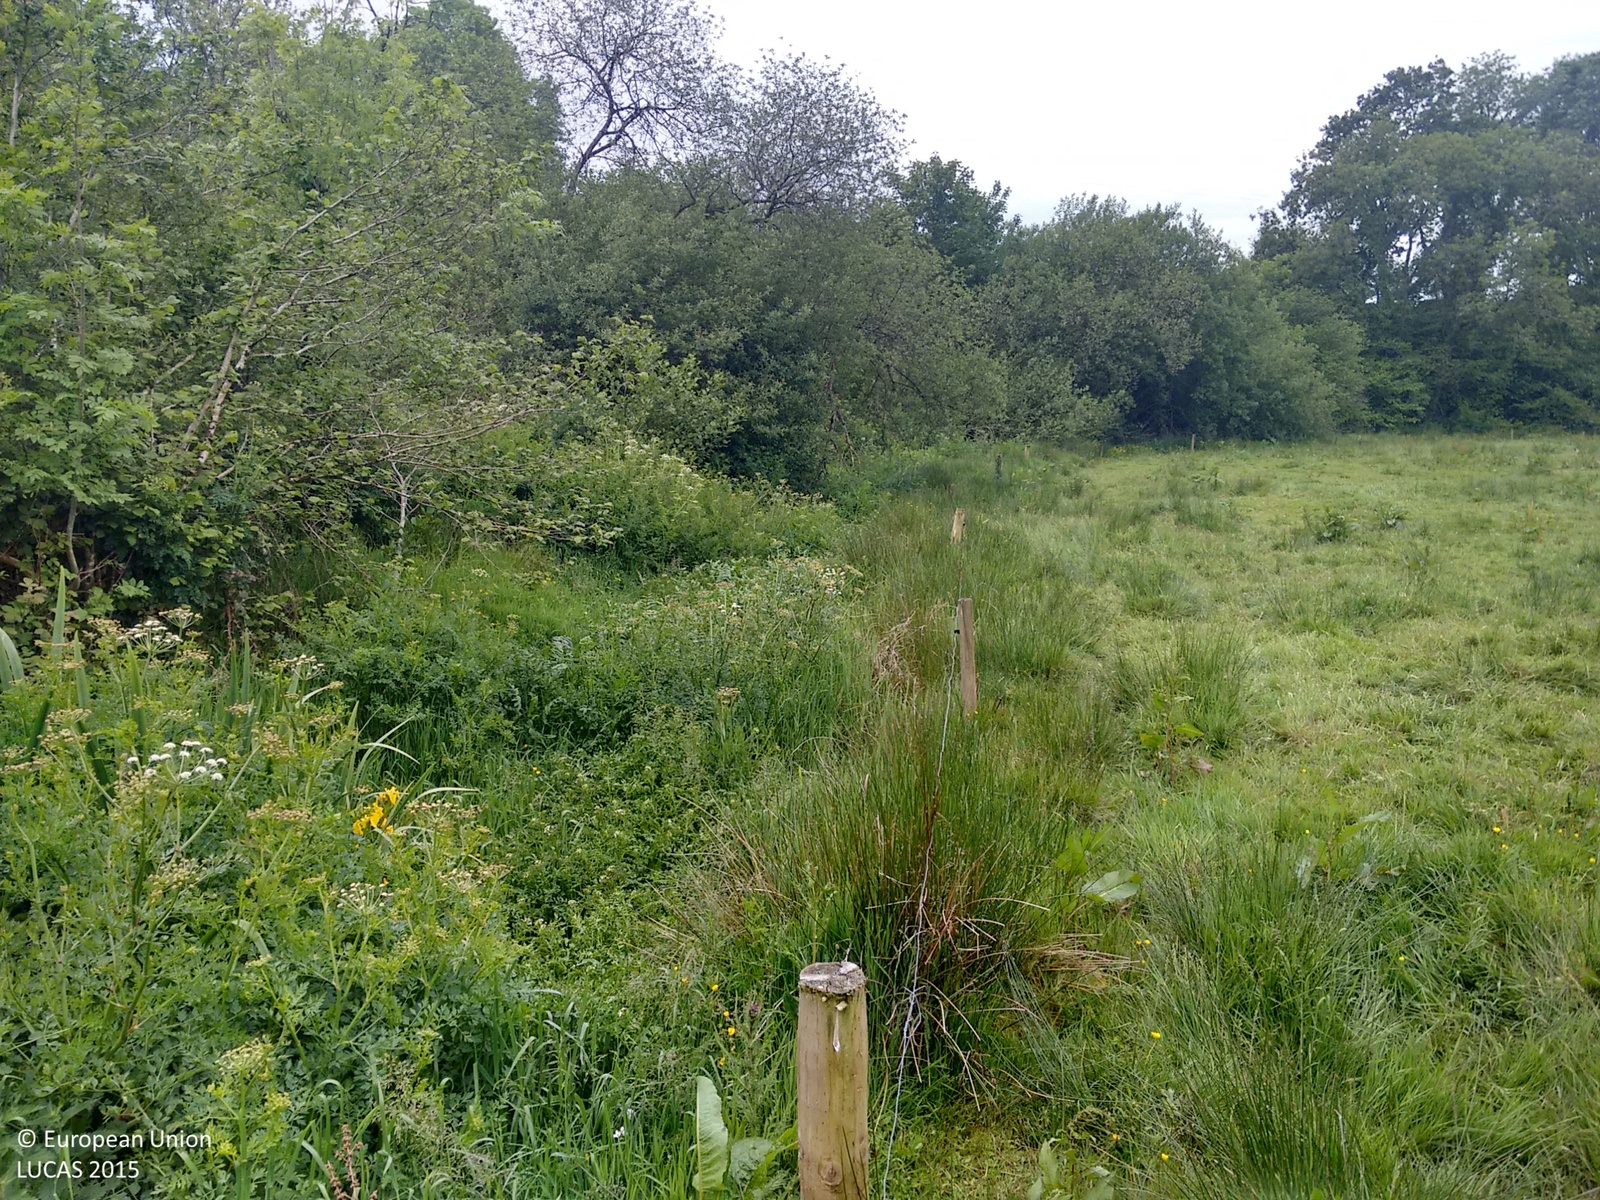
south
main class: Grassland
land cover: Grassland without tree/shrub cover
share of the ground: > 75 %
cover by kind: herbaceous plants 100 %
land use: Agriculture (excluding fallow land and kitchen gardens)
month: June
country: IE
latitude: 52.0513
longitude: -8.3738
